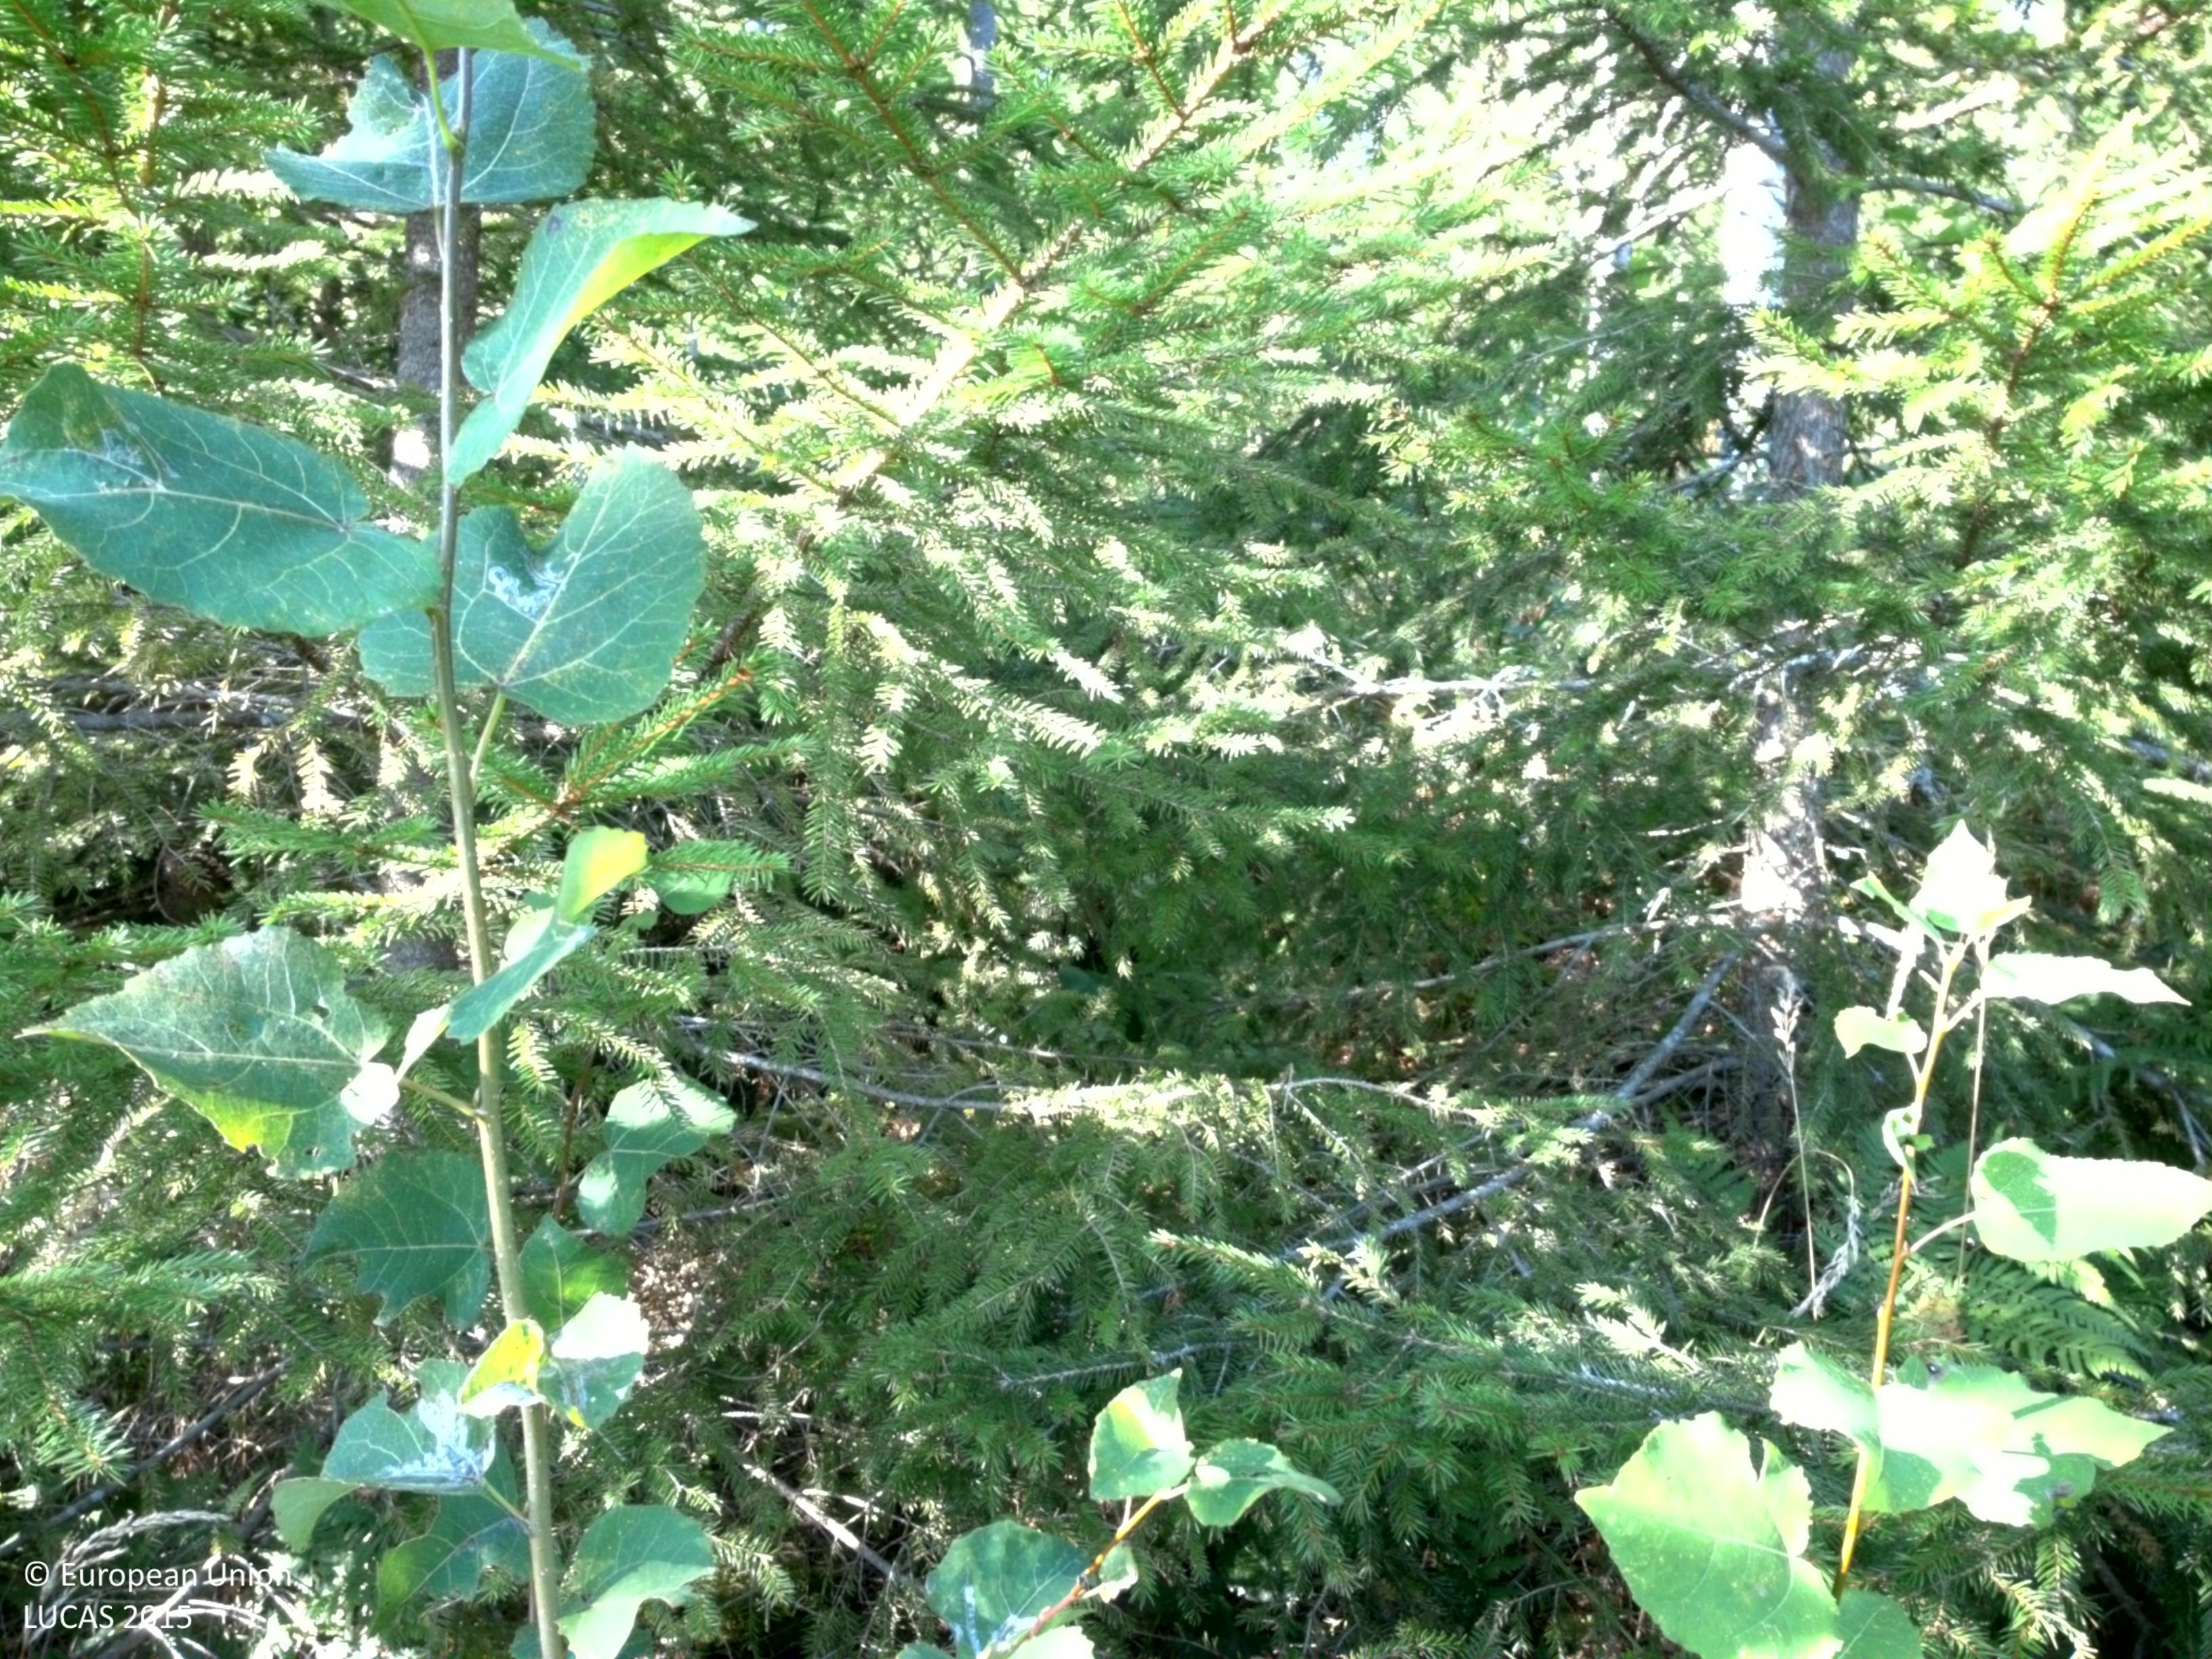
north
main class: Woodland
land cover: Spruce dominated mixed woodland
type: boreal forest
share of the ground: > 75 %
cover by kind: broadleaved forest trees 50 %, coniferous forest trees 40 %, herbaceous plants 10 %
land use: Forestry
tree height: > 5 m
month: August
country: SE
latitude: 59.5868
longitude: 15.9240
